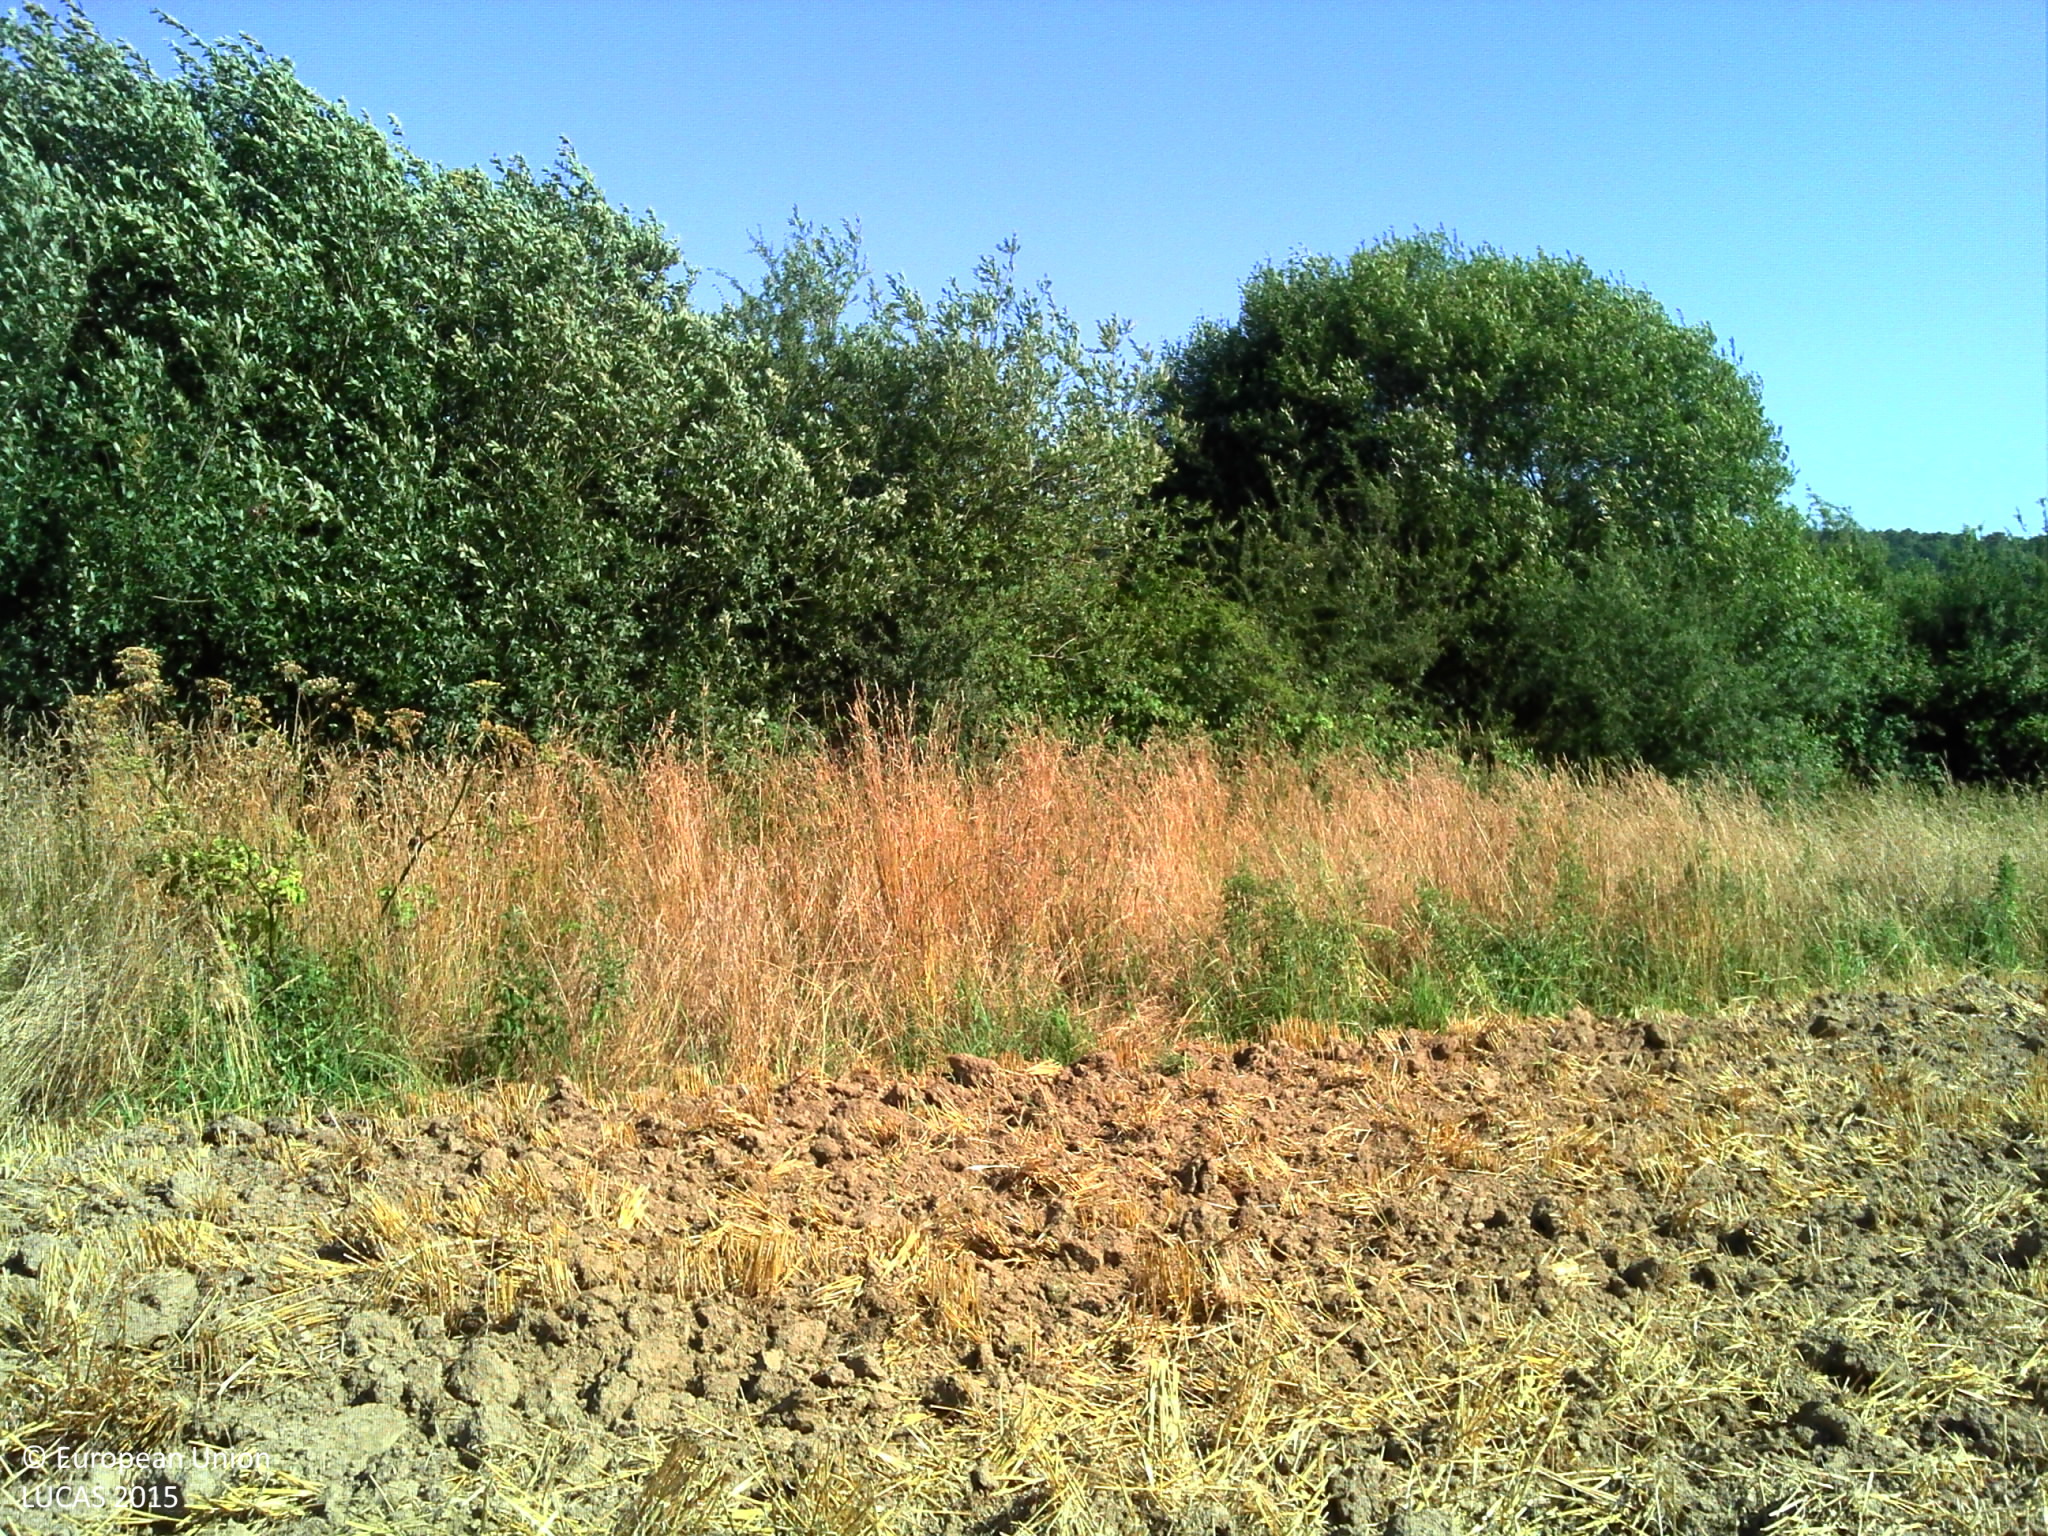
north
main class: Cropland
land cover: Barley
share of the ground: 10 - 25 %
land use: Agriculture (excluding fallow land and kitchen gardens)
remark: Harvested field
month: July
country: FR
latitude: 47.8723
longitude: -1.8548
